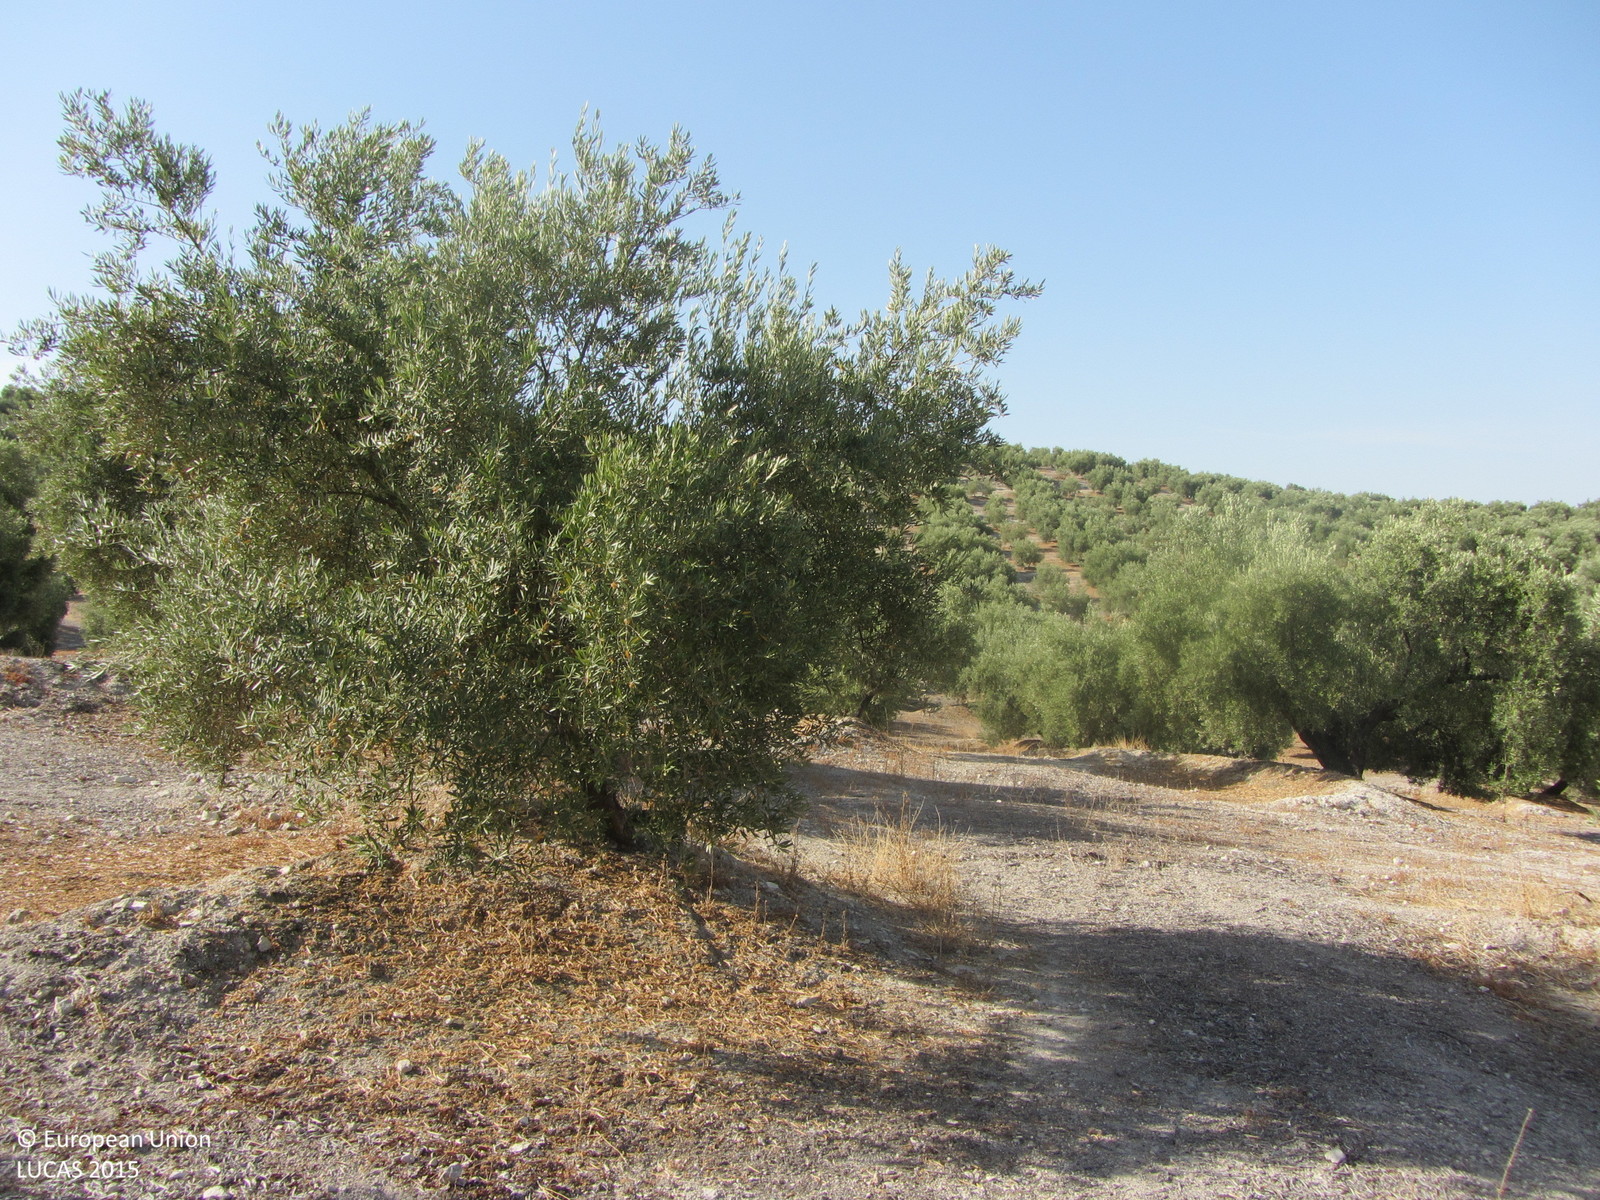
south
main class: Cropland
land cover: Olive groves
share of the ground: 25 - 50 %
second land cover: Other bare soil
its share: > 75 %
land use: Agriculture (excluding fallow land and kitchen gardens)
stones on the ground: < 10 %
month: July
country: ES
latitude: 37.6771
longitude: -4.1420
